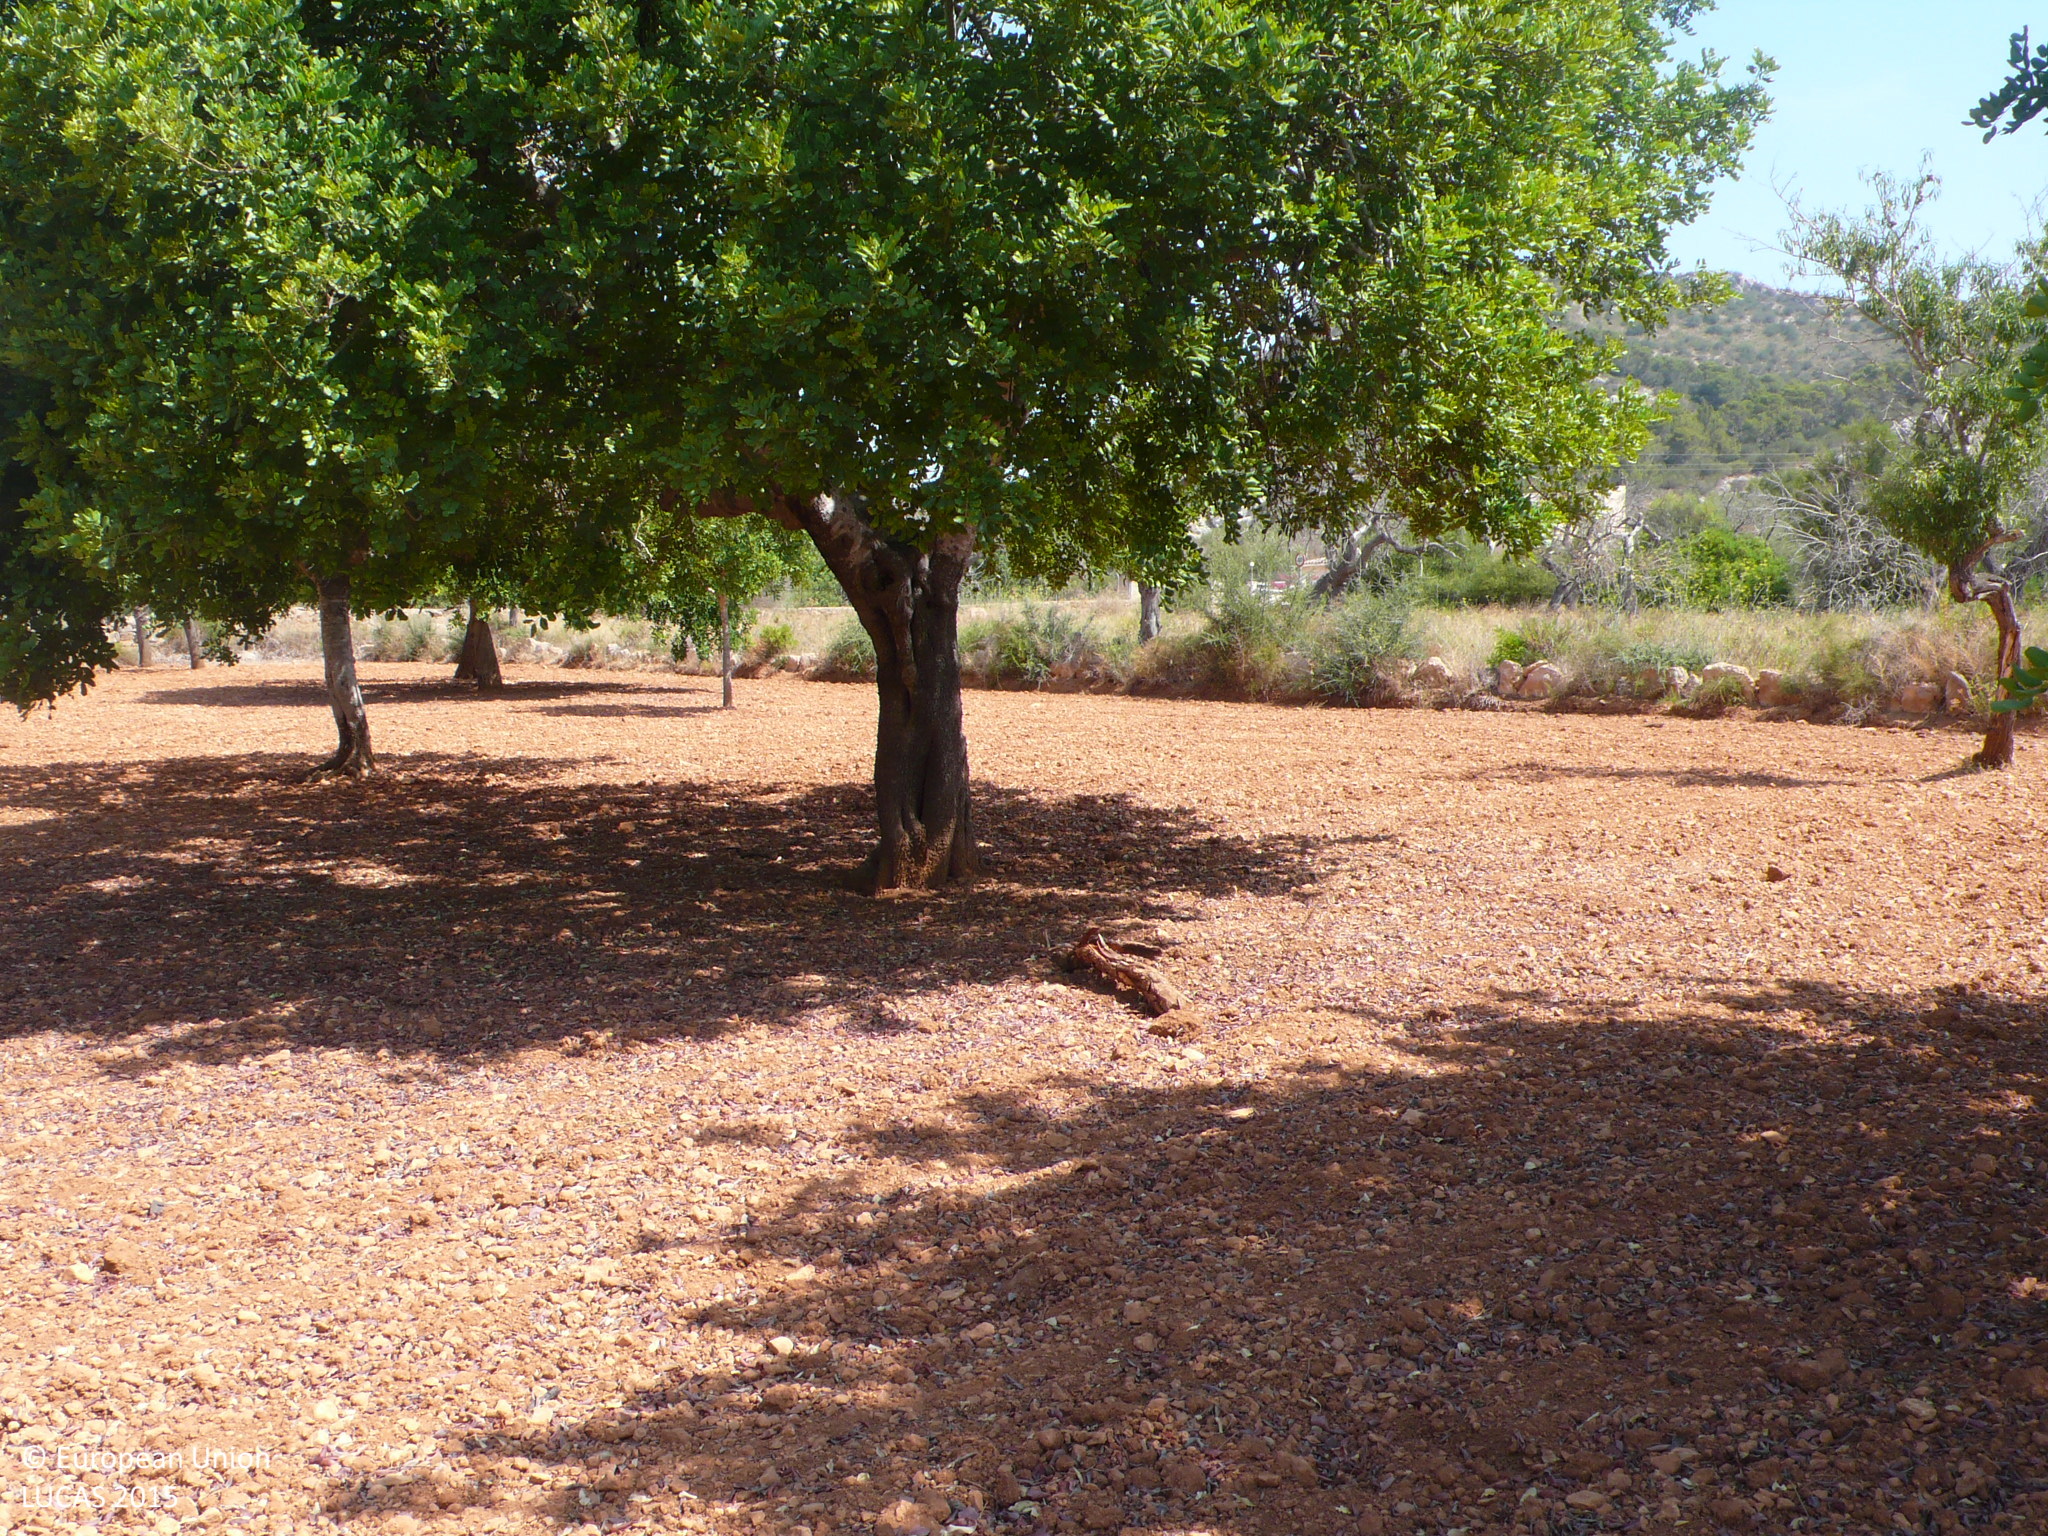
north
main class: Cropland
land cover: Nuts trees
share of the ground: 25 - 50 %
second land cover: Other bare soil
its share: > 75 %
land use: Agriculture (excluding fallow land and kitchen gardens)
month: July
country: ES
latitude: 39.5177
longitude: 2.8771
